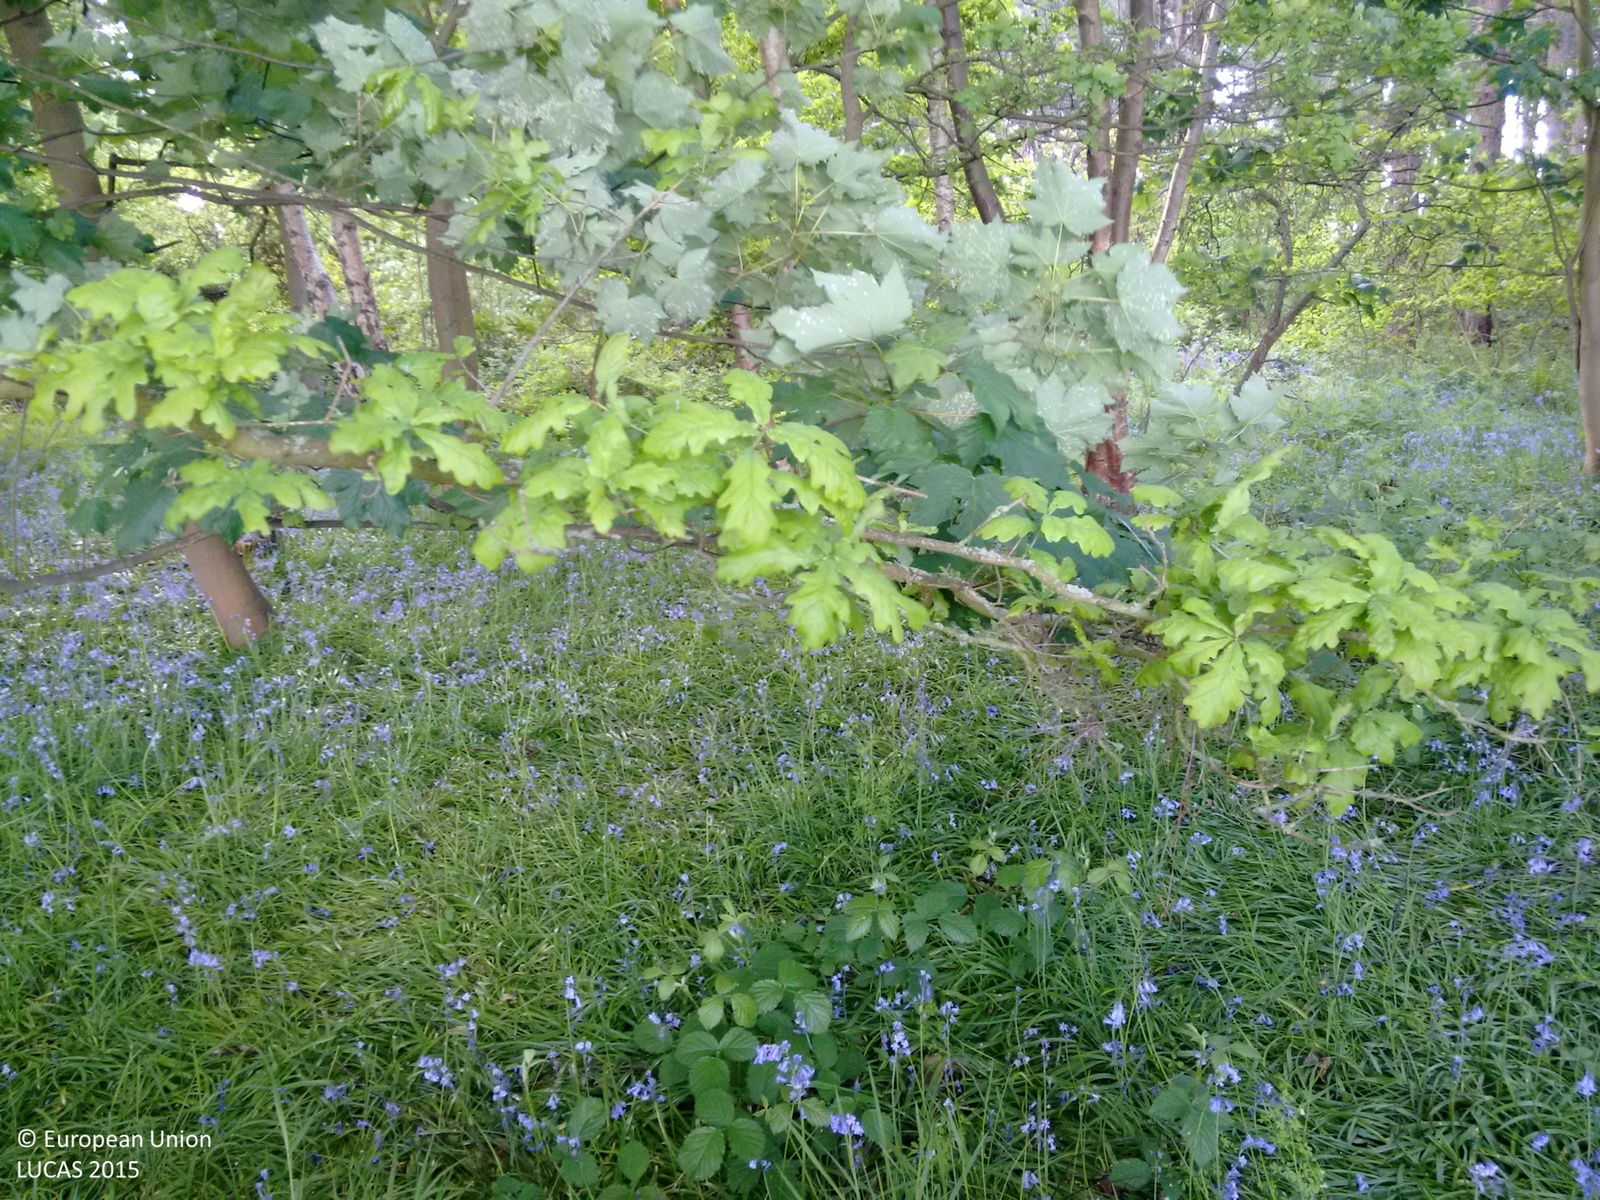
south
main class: Woodland
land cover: Broadleaved woodland
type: mesophytic deciduous forest
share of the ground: > 75 %
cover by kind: broadleaved forest trees 100 %
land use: Semi-natural and natural areas not in use
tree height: > 5 m
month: May
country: GB
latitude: 53.5129
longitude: -1.0372
